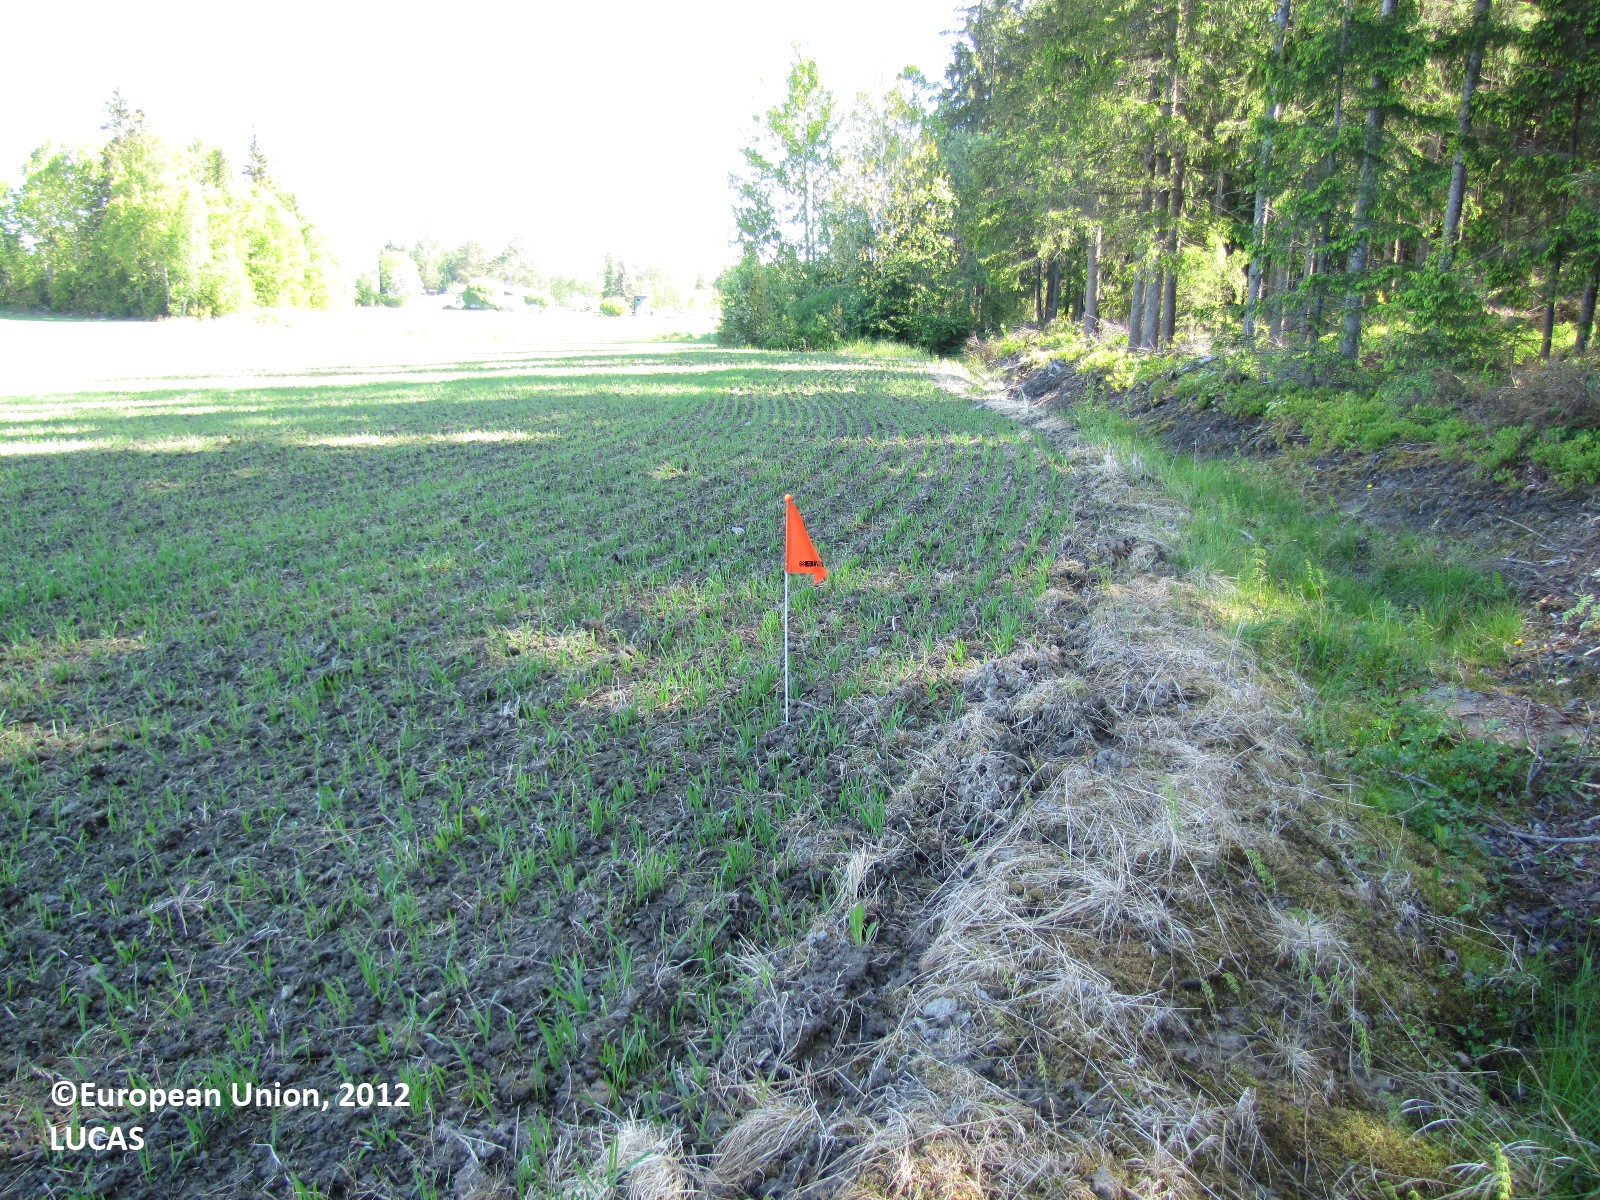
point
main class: Cropland
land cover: Oats
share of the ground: < 10 %
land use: Agriculture (excluding fallow land and kitchen gardens)
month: June
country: FI
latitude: 61.3298
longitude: 23.0212
